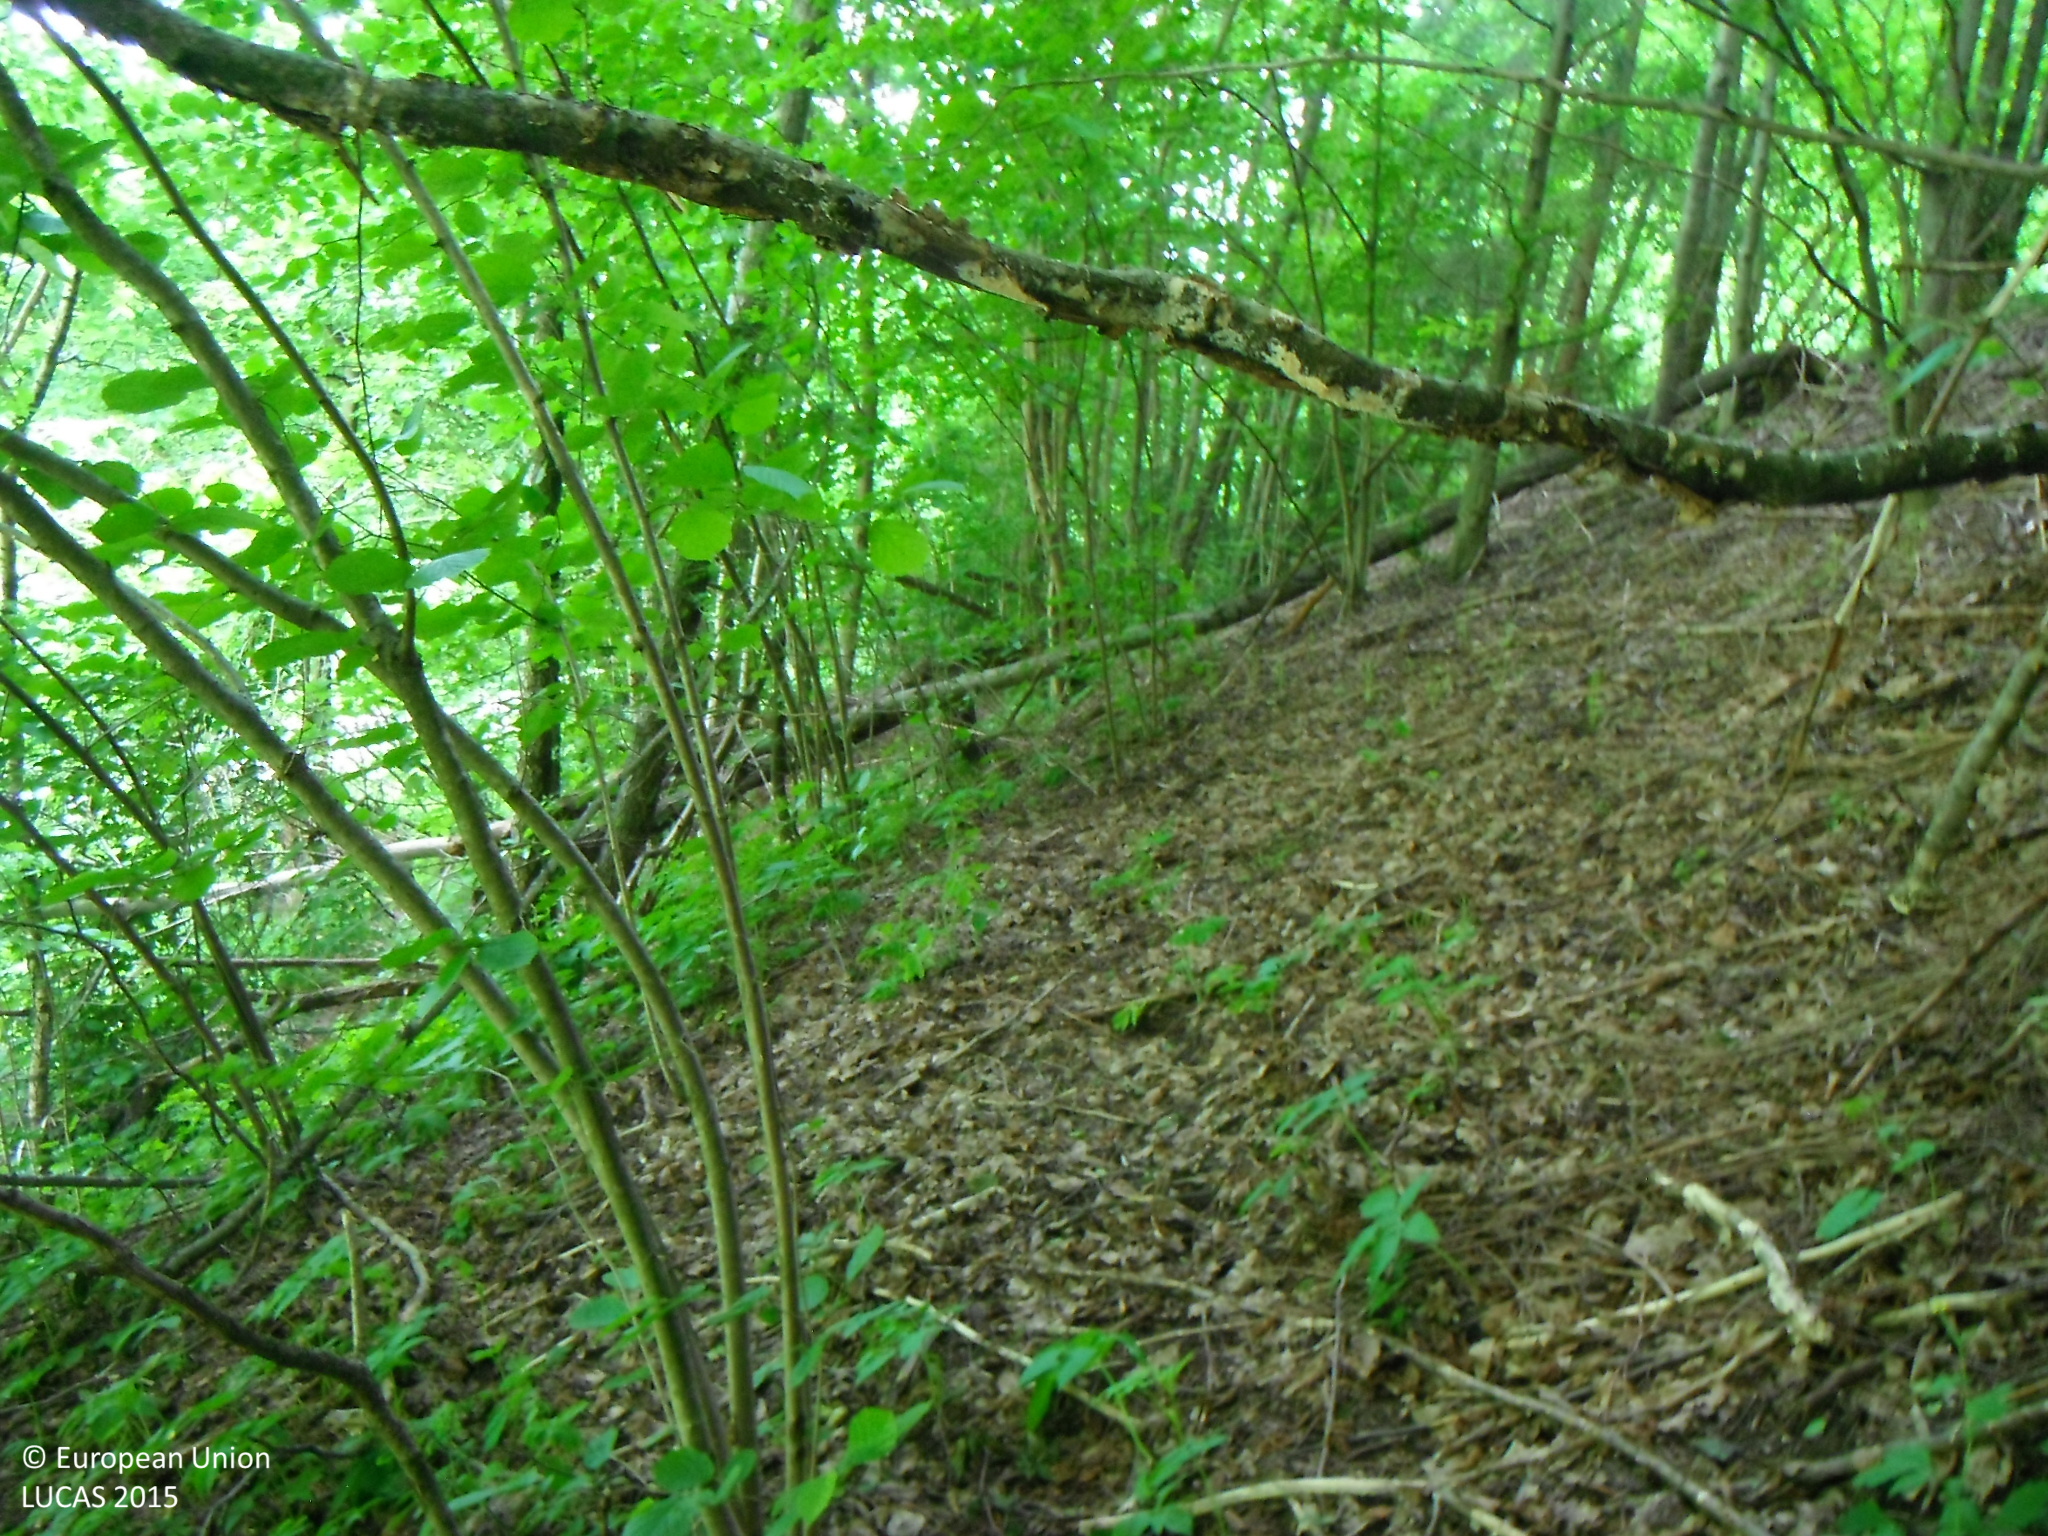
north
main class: Woodland
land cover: Broadleaved woodland
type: mesophytic deciduous forest
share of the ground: > 75 %
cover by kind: broadleaved forest trees 90 %, shrubs 5 %, herbaceous plants 5 %
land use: Forestry
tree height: > 5 m
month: June
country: SK
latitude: 48.6342
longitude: 19.8391
